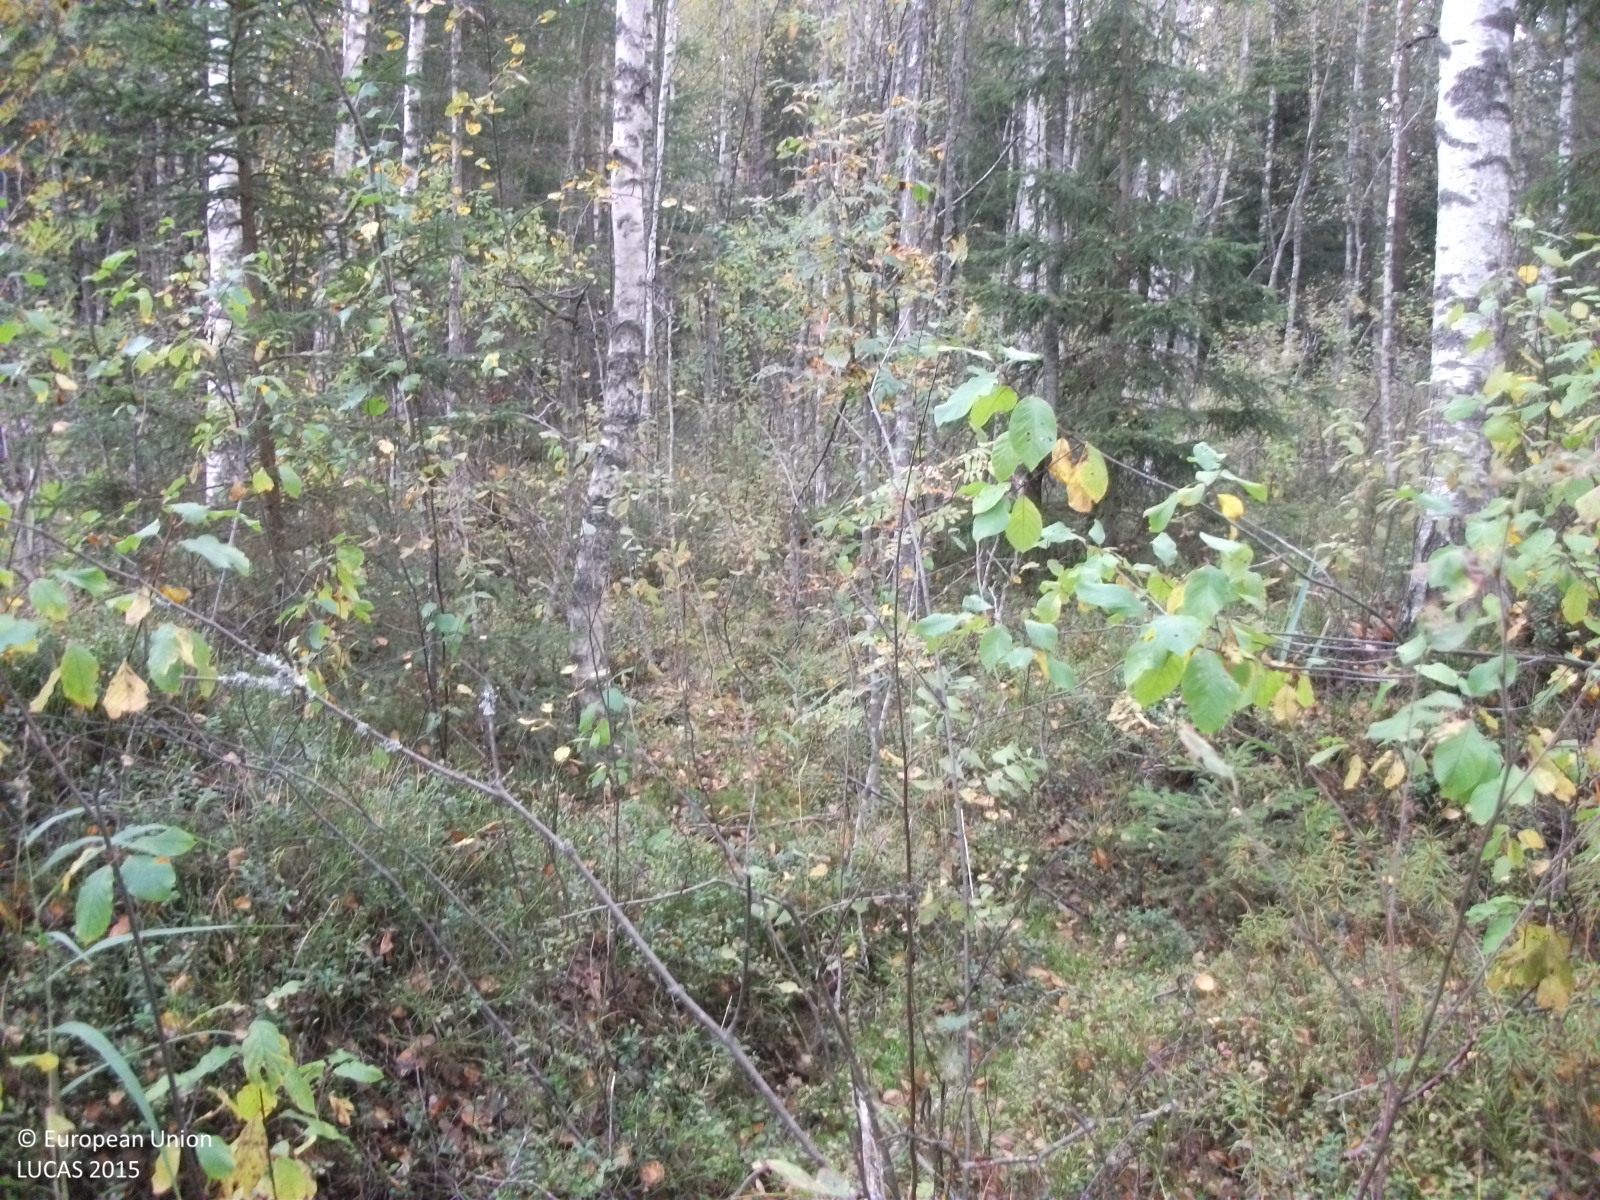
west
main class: Woodland
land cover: Spruce dominated mixed woodland
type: hemiboreal forest and nemoral coniferous forest and mixed broadleaved-coniferous forest
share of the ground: > 75 %
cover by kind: coniferous forest trees 50 %, broadleaved forest trees 35 %, herbaceous plants 10 %, shrubs 5 %
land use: Forestry
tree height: > 5 m
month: September
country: LV
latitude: 57.9472
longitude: 24.6031
